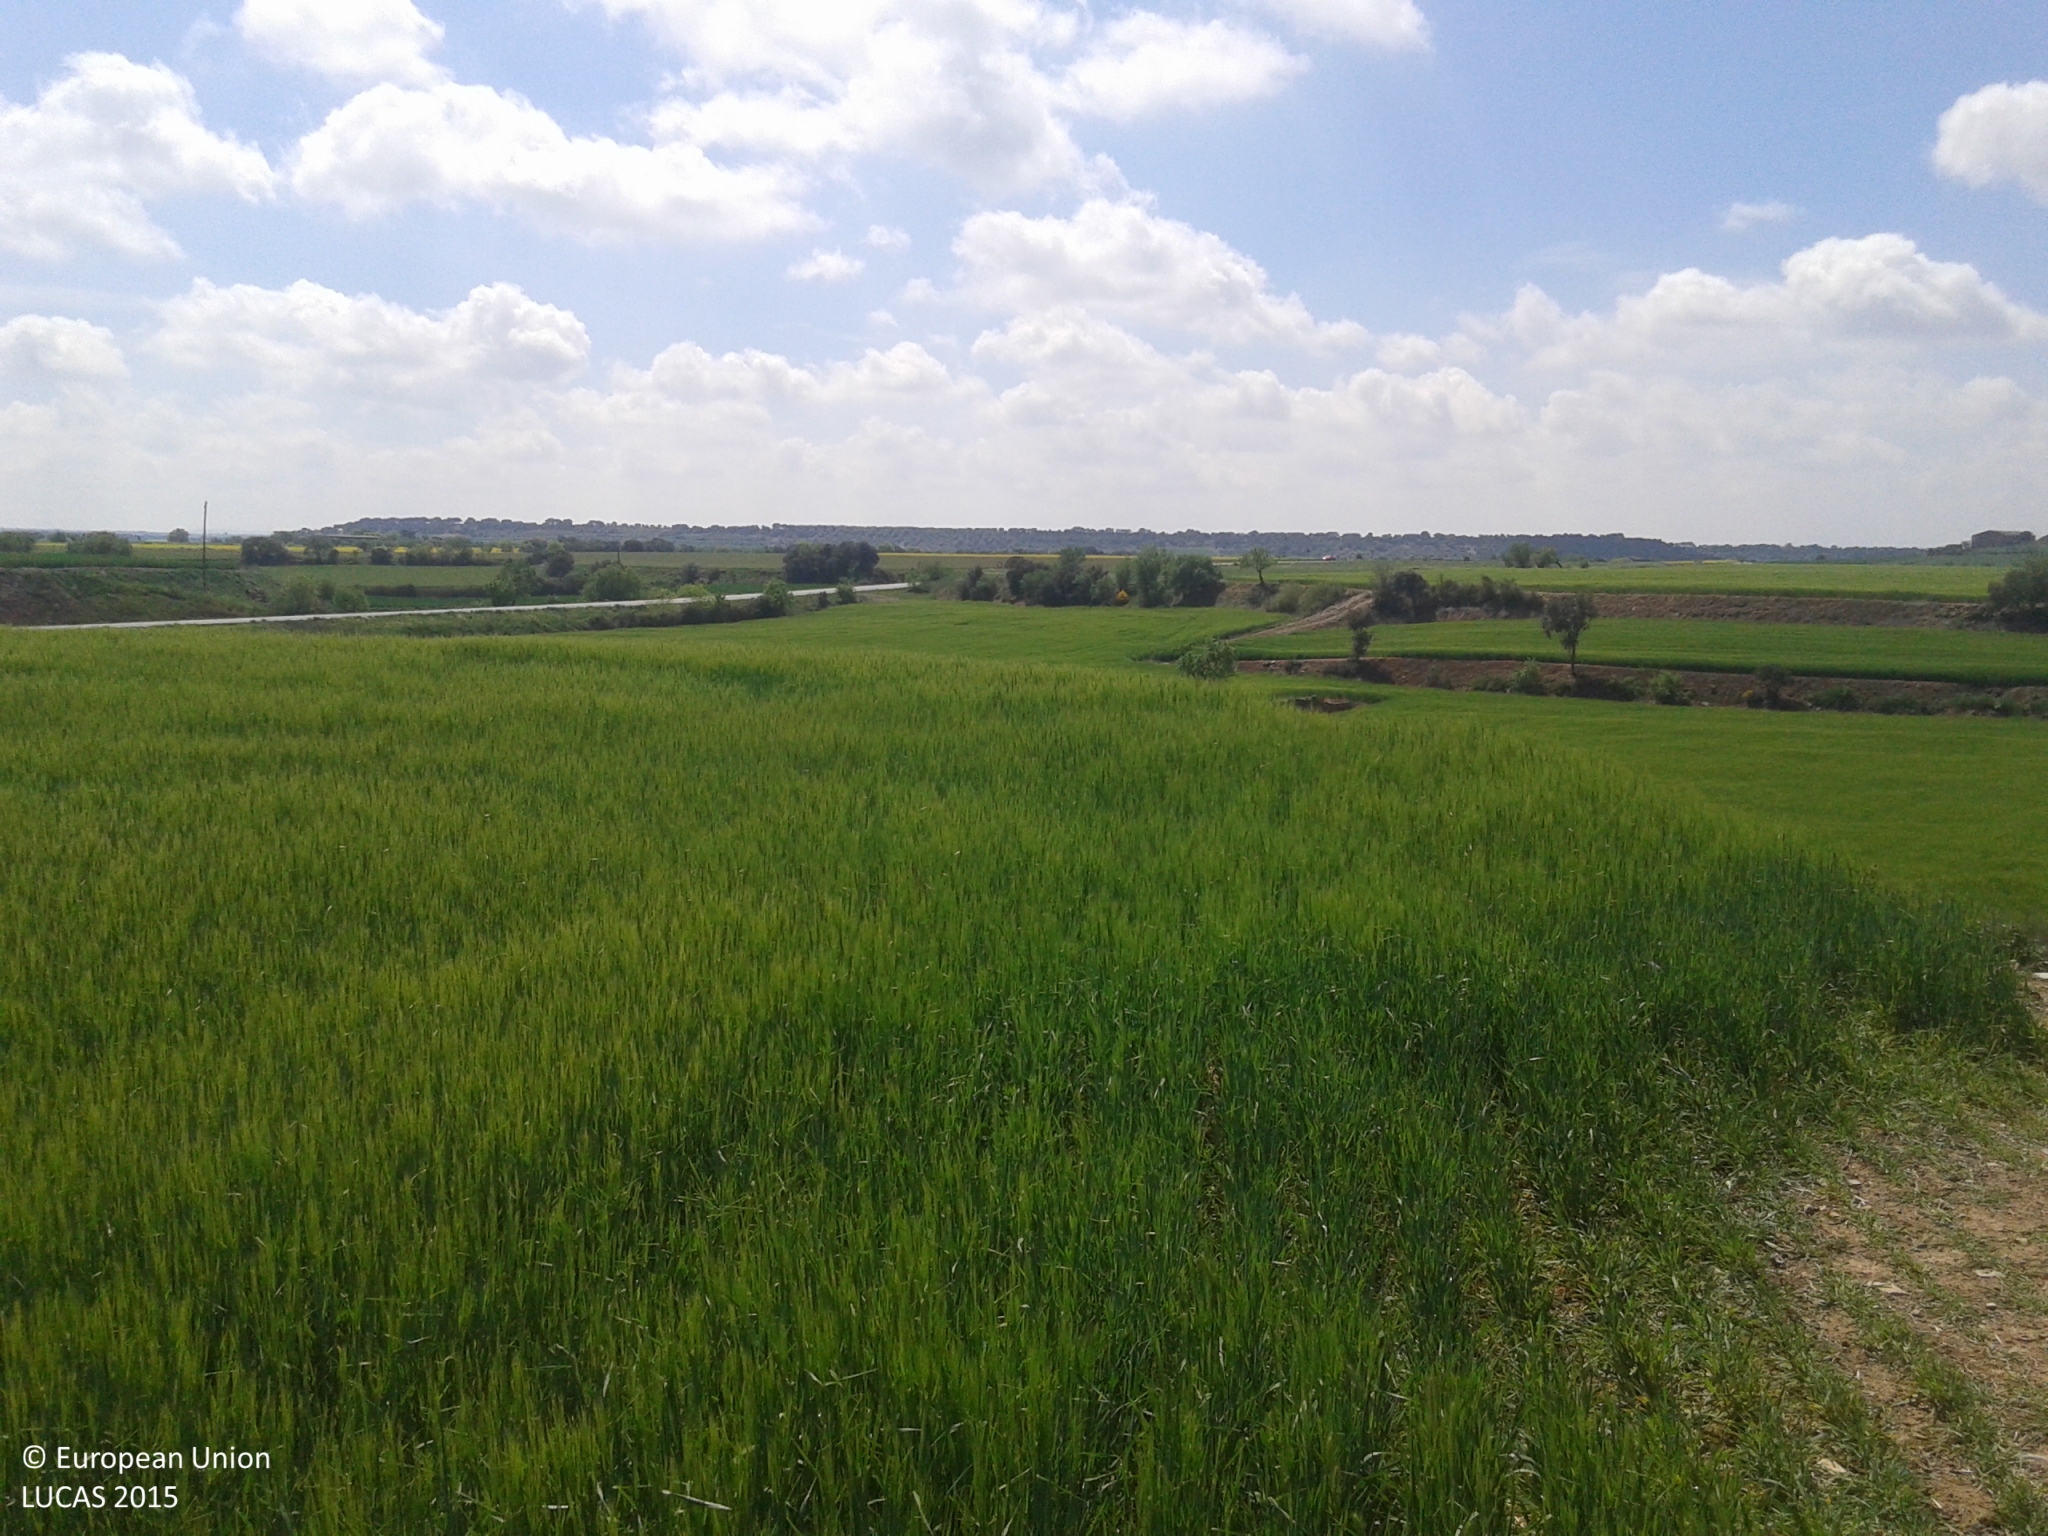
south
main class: Cropland
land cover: Barley
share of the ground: > 75 %
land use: Agriculture (excluding fallow land and kitchen gardens)
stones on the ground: 25 - 50 %
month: April
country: ES
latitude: 41.7056
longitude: 1.1804
